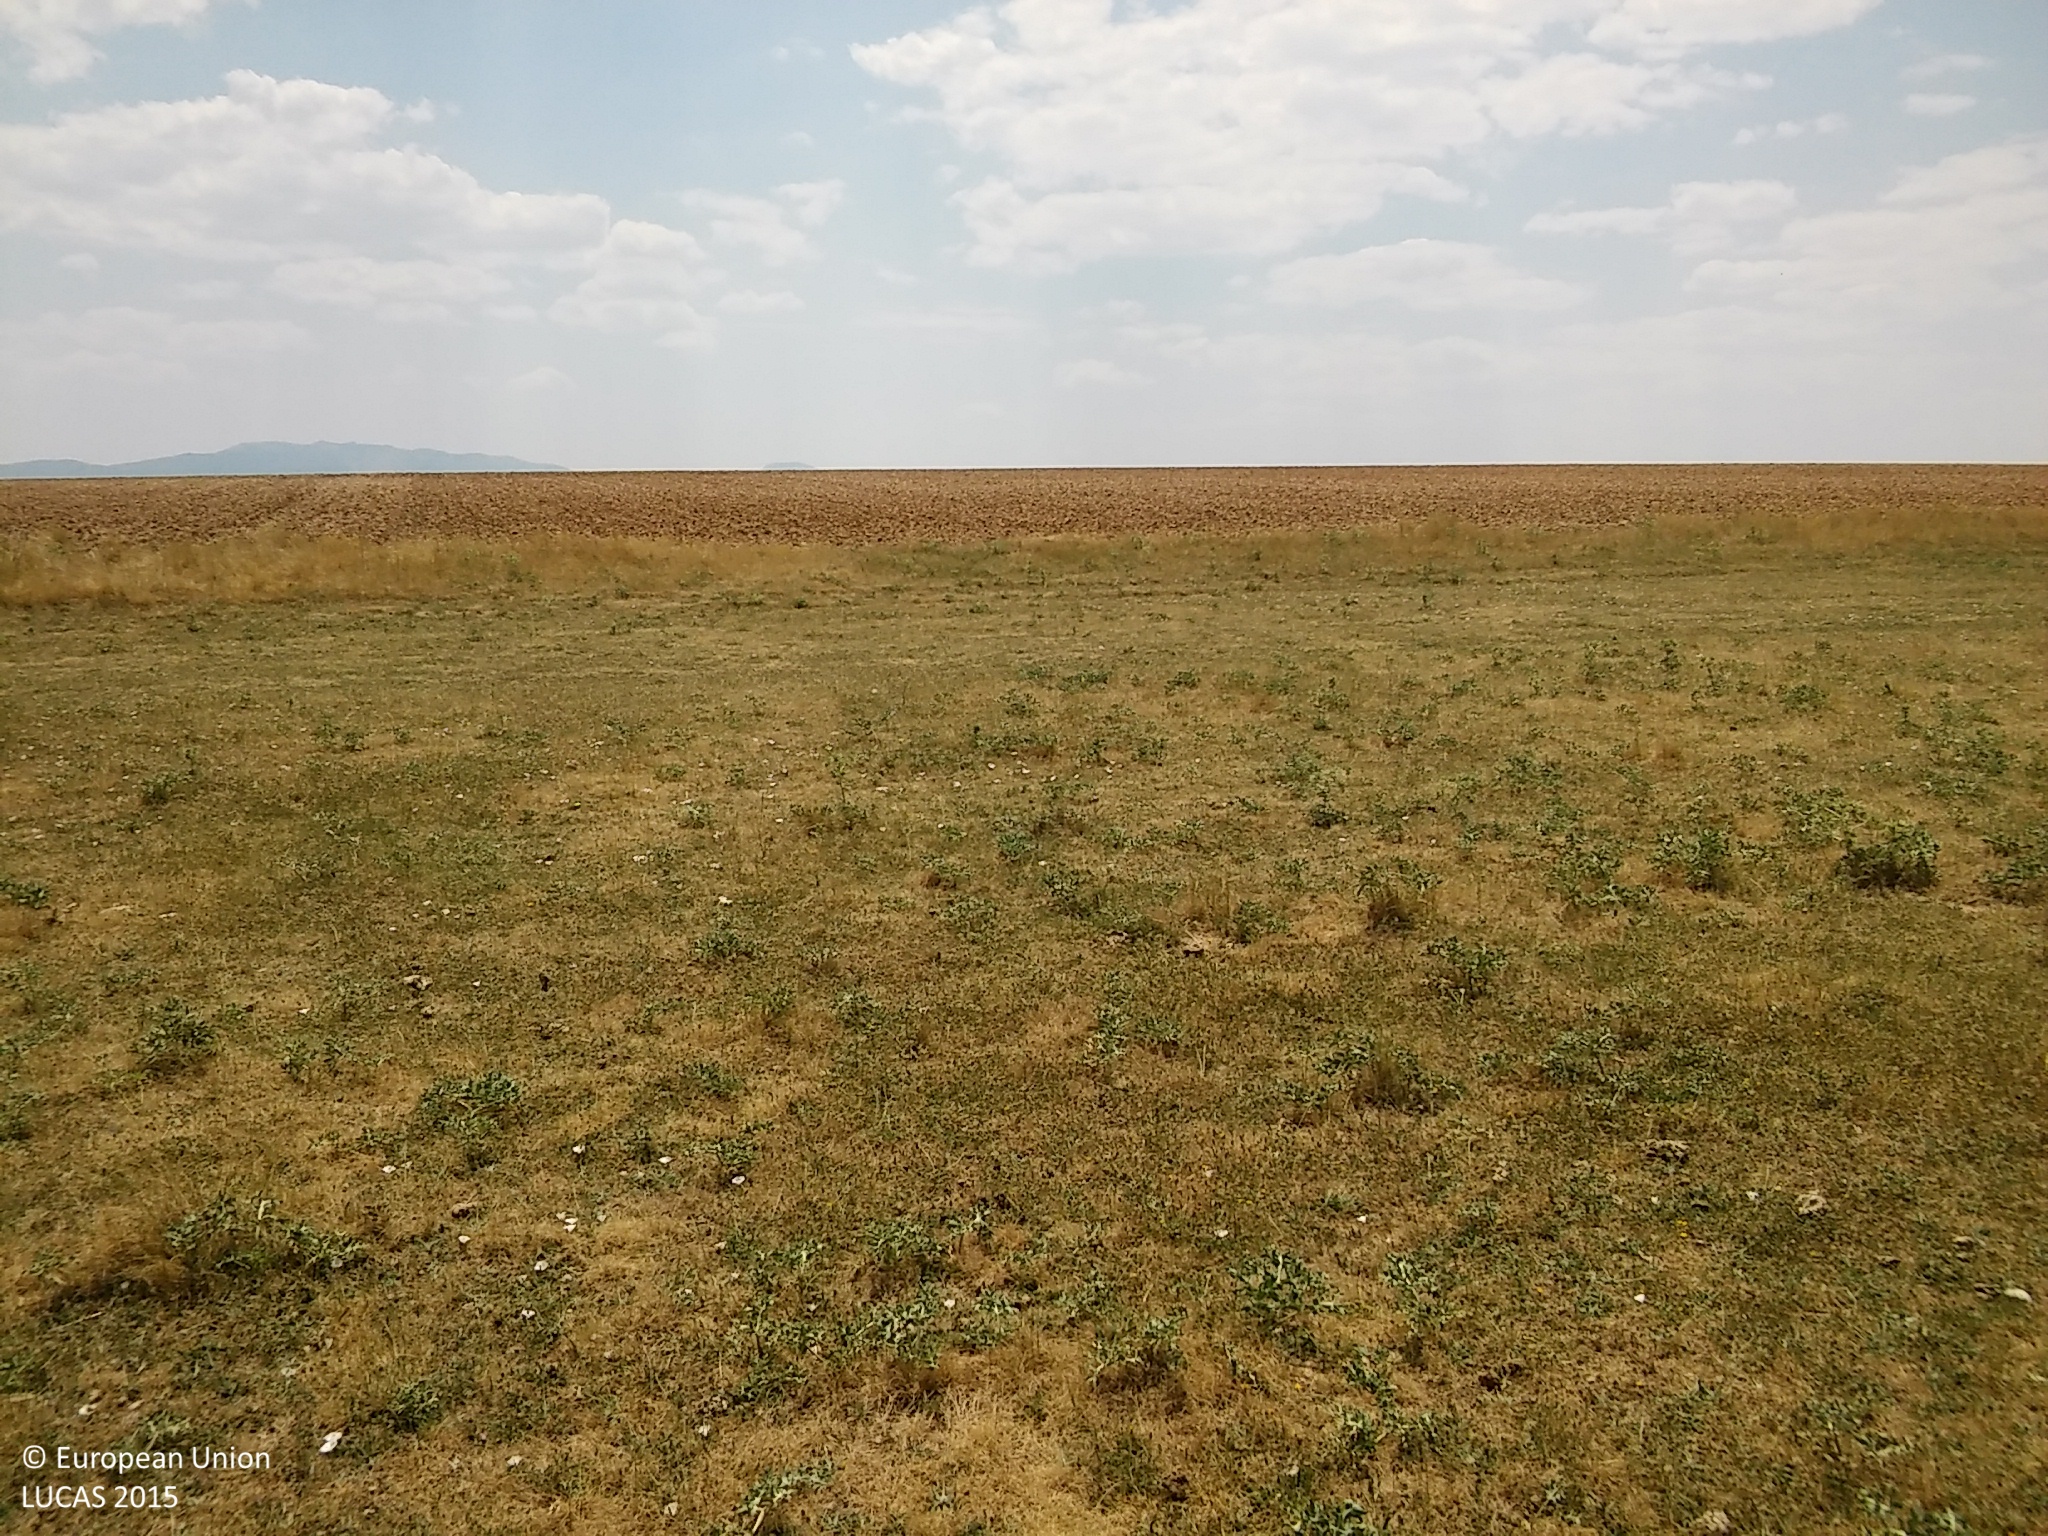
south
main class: Grassland
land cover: Grassland without tree/shrub cover
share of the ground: > 75 %
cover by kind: herbaceous plants 100 %
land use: Agriculture (excluding fallow land and kitchen gardens)
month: June
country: ES
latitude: 41.4123
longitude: -3.5302
